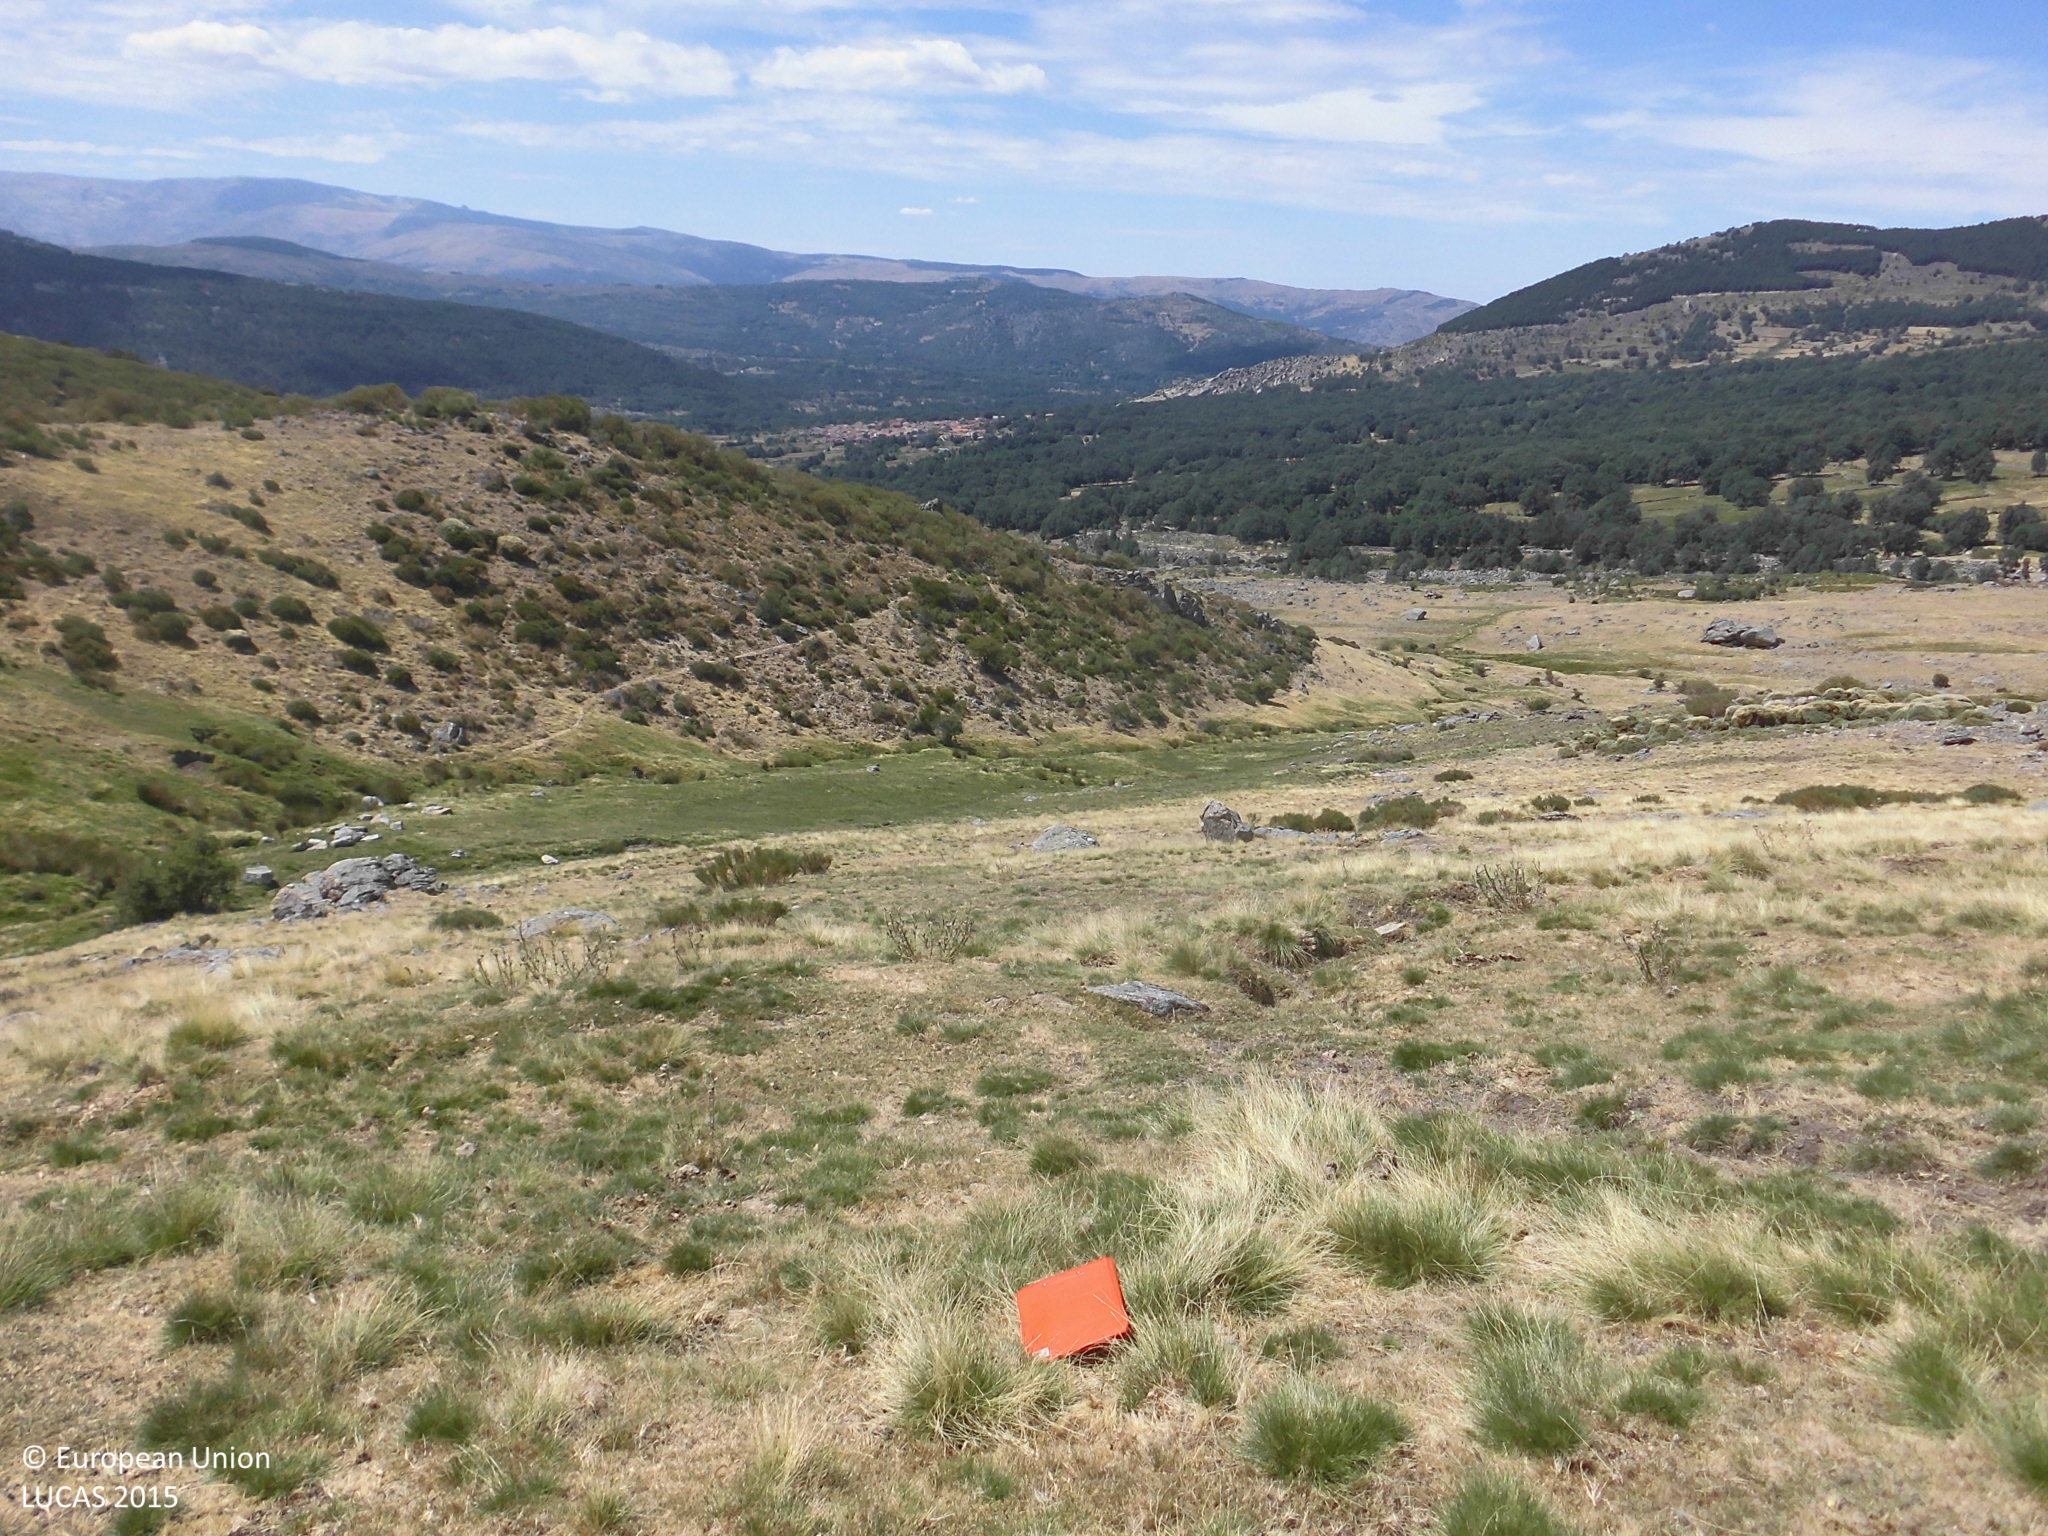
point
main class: Grassland
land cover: Grassland without tree/shrub cover
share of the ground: > 75 %
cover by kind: herbaceous plants 100 %
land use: Agriculture (excluding fallow land and kitchen gardens)
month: July
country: ES
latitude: 40.2620
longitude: -5.4786
